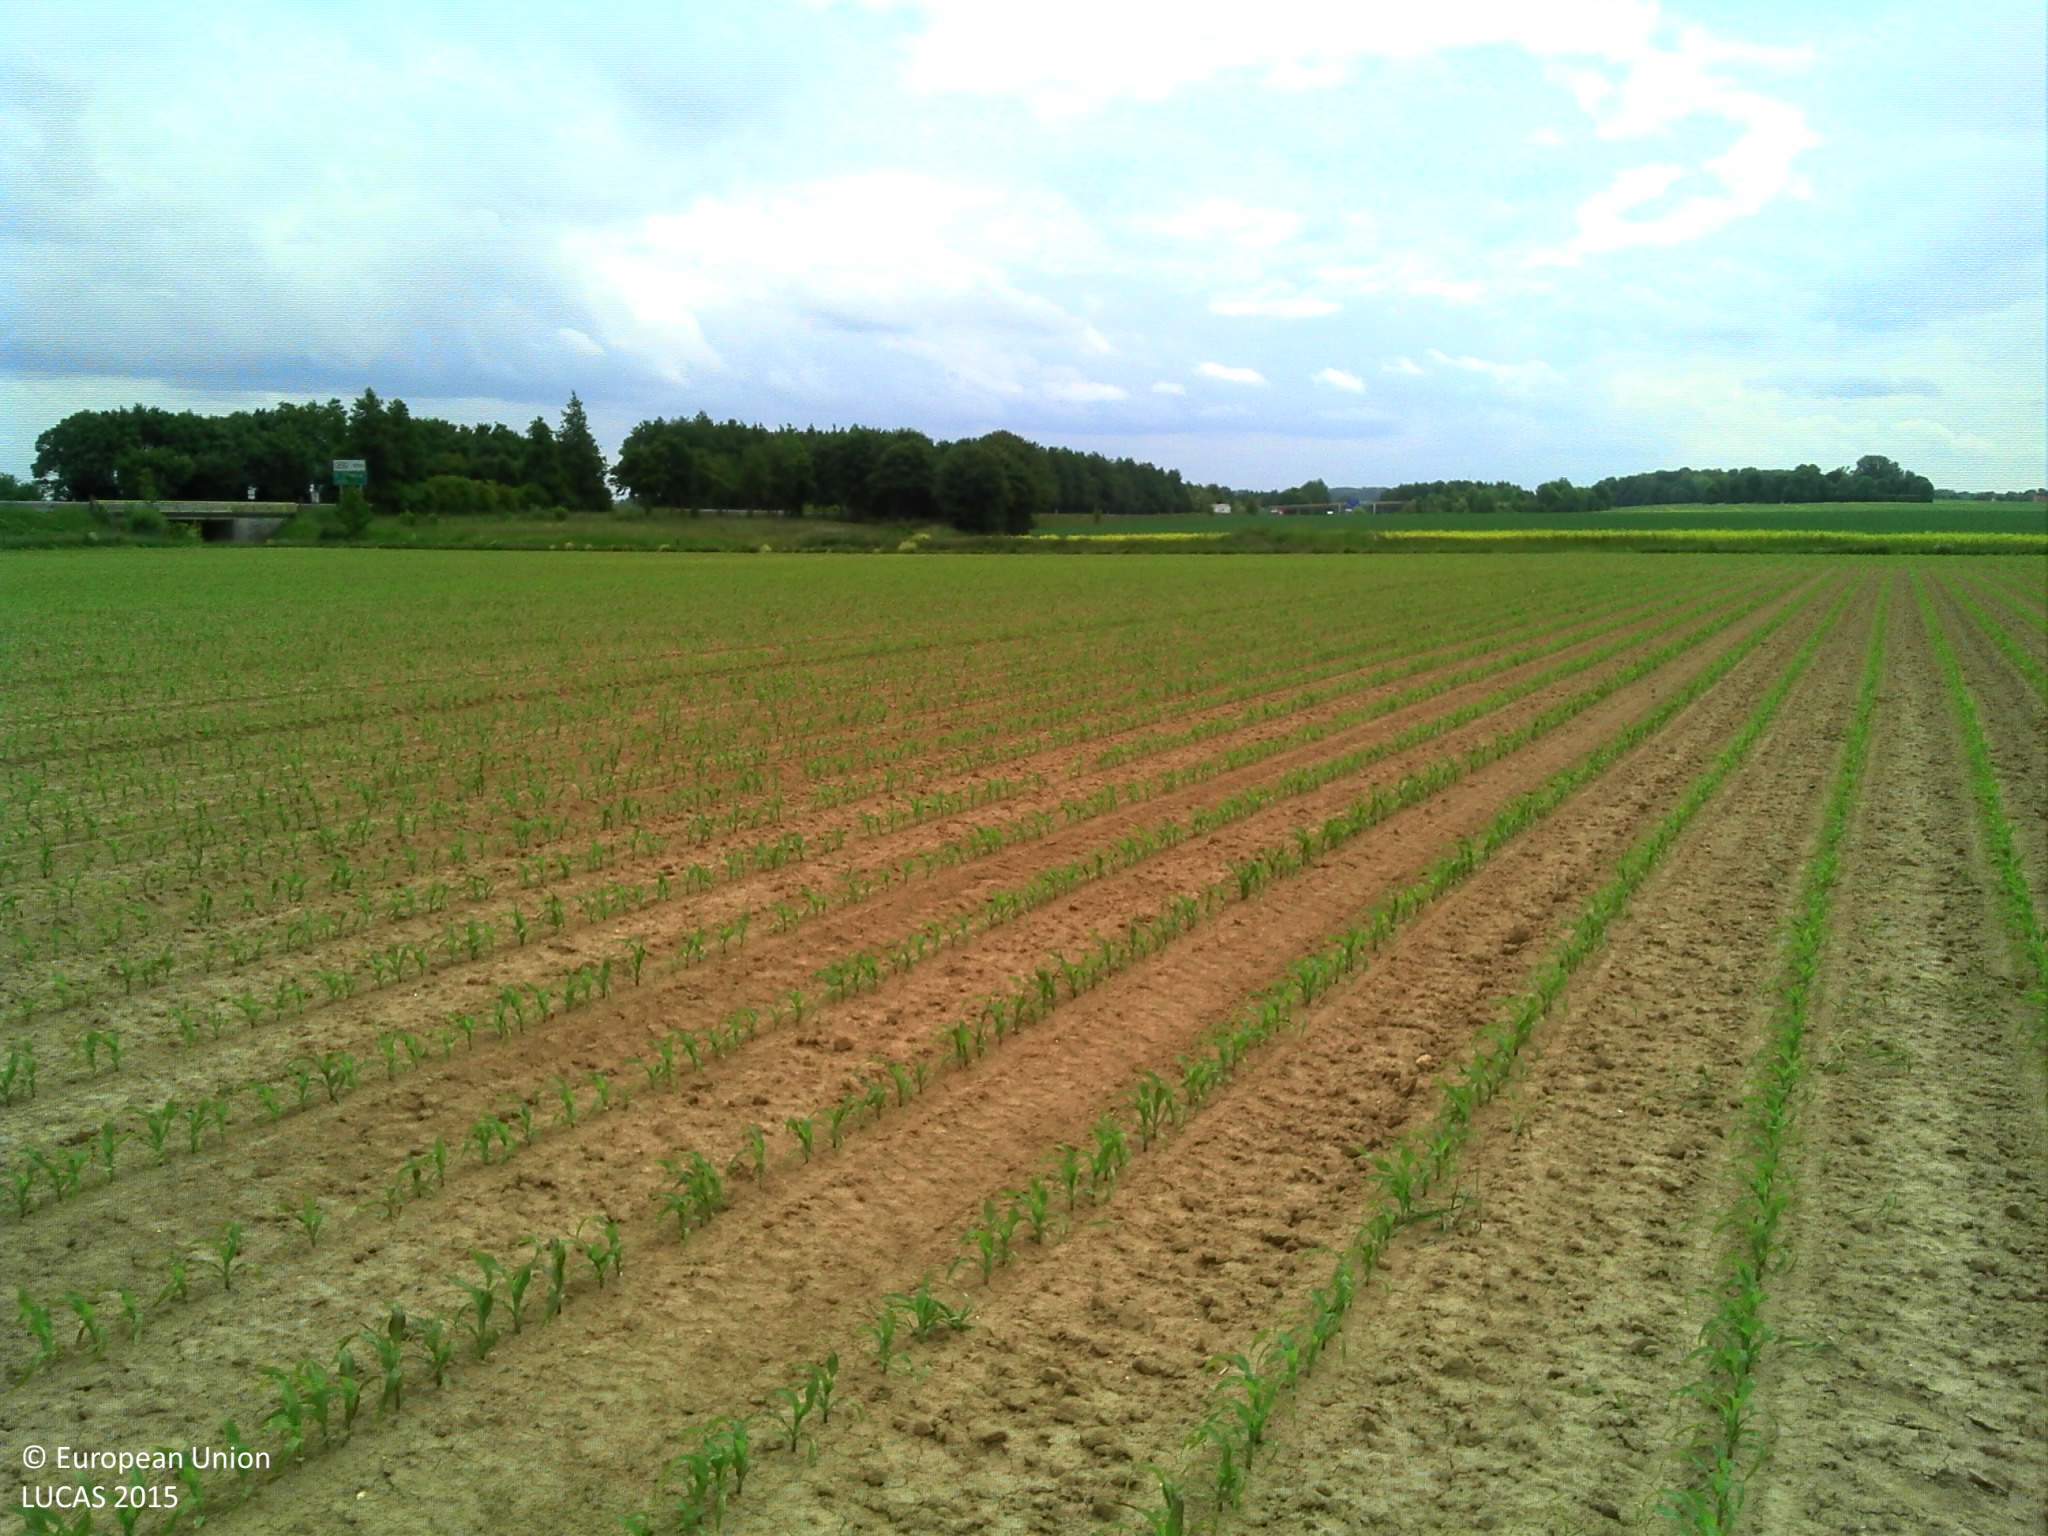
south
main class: Cropland
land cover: Maize
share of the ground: < 10 %
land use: Agriculture (excluding fallow land and kitchen gardens)
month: May
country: FR
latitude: 49.8754
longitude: 3.2426
